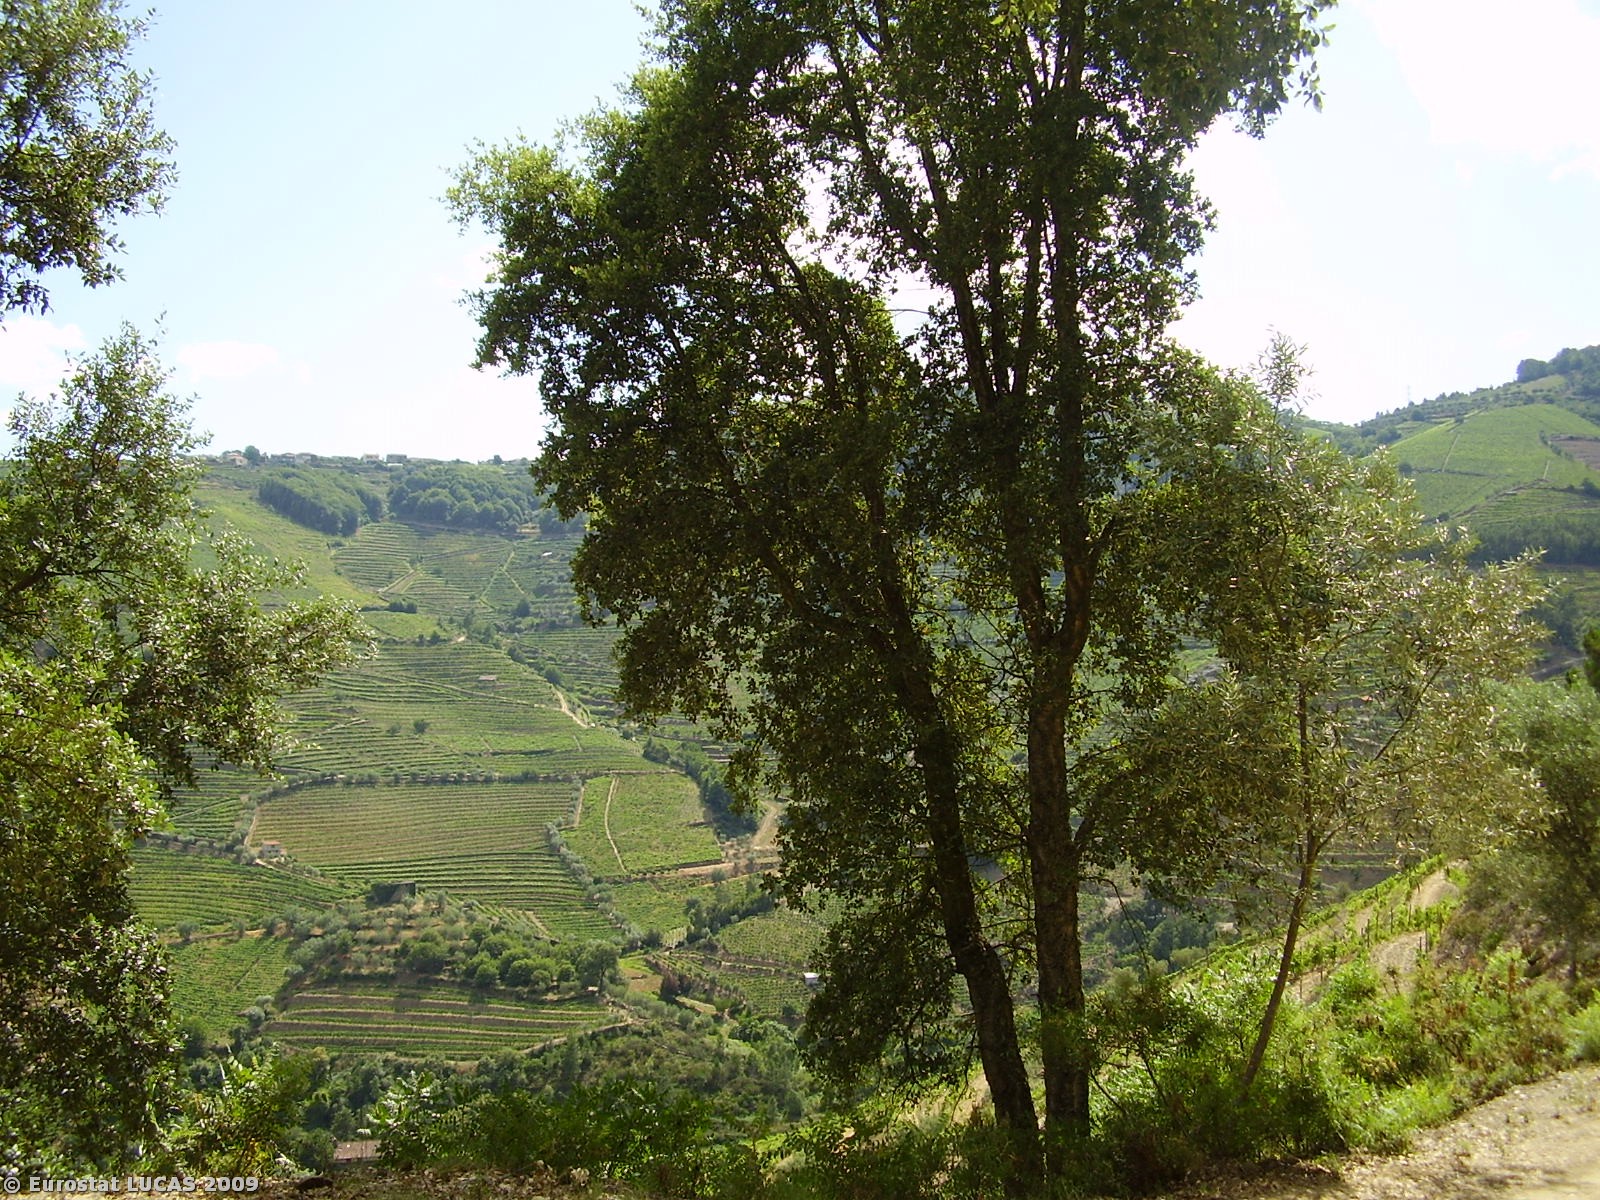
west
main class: Woodland
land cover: Broadleaved woodland
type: broadleaved evergreen forest
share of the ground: > 75 %
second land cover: Spontaneously vegetated surfaces
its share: 10 - 25 %
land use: Unused
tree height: > 5 m
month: July
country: PT
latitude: 41.2188
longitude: -7.6490
